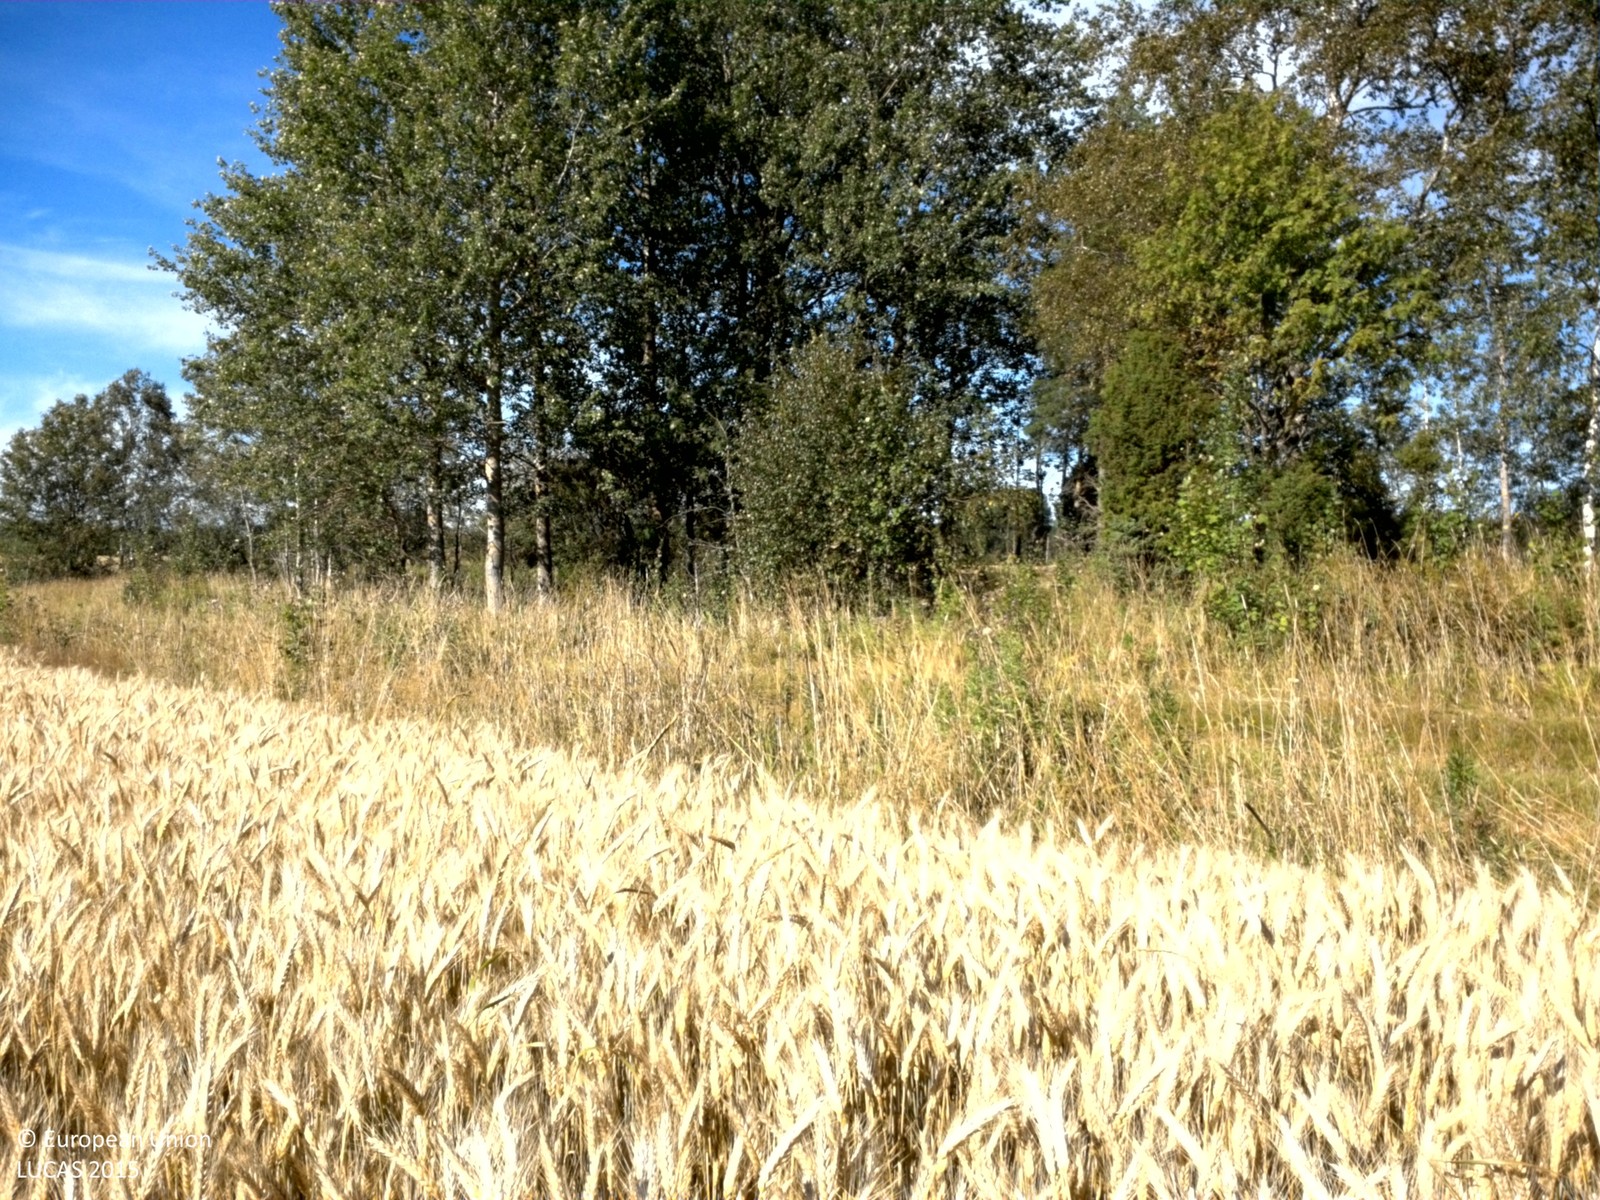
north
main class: Cropland
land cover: Rye
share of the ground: > 75 %
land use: Agriculture (excluding fallow land and kitchen gardens)
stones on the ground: < 10 %
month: August
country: SE
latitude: 60.1677
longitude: 17.0374
